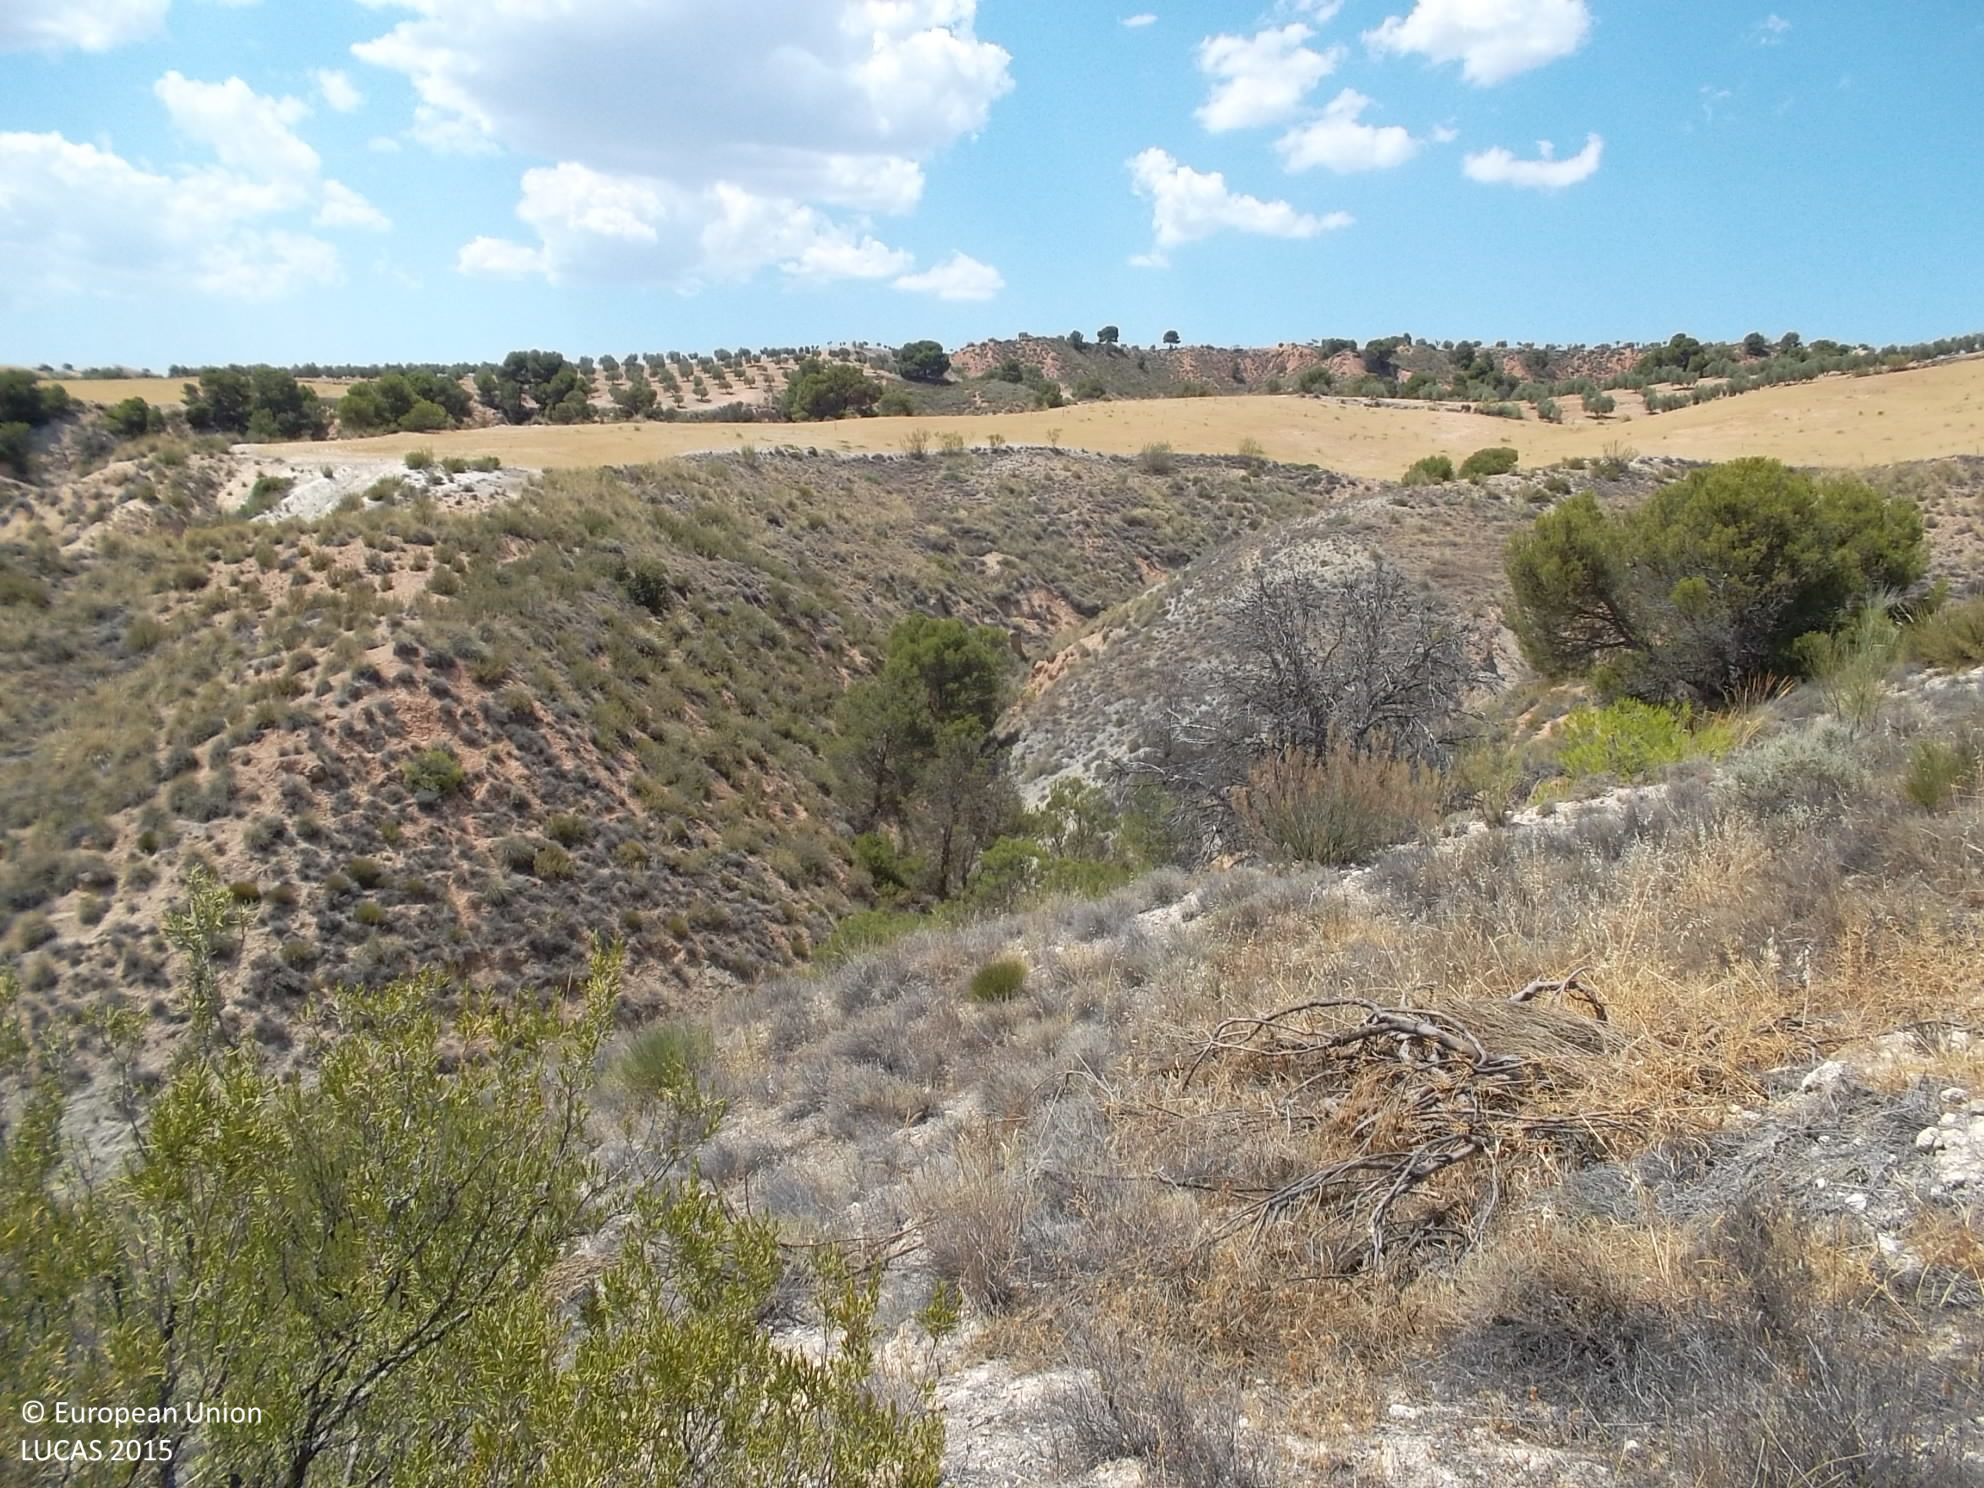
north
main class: Grassland
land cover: Grassland with sparse tree/shrub cover
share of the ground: > 75 %
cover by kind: herbaceous plants 85 %, shrubs 10 %, broadleaved forest trees 5 %
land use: Semi-natural and natural areas not in use
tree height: < 5 m
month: June
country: ES
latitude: 37.6490
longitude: -3.1972
